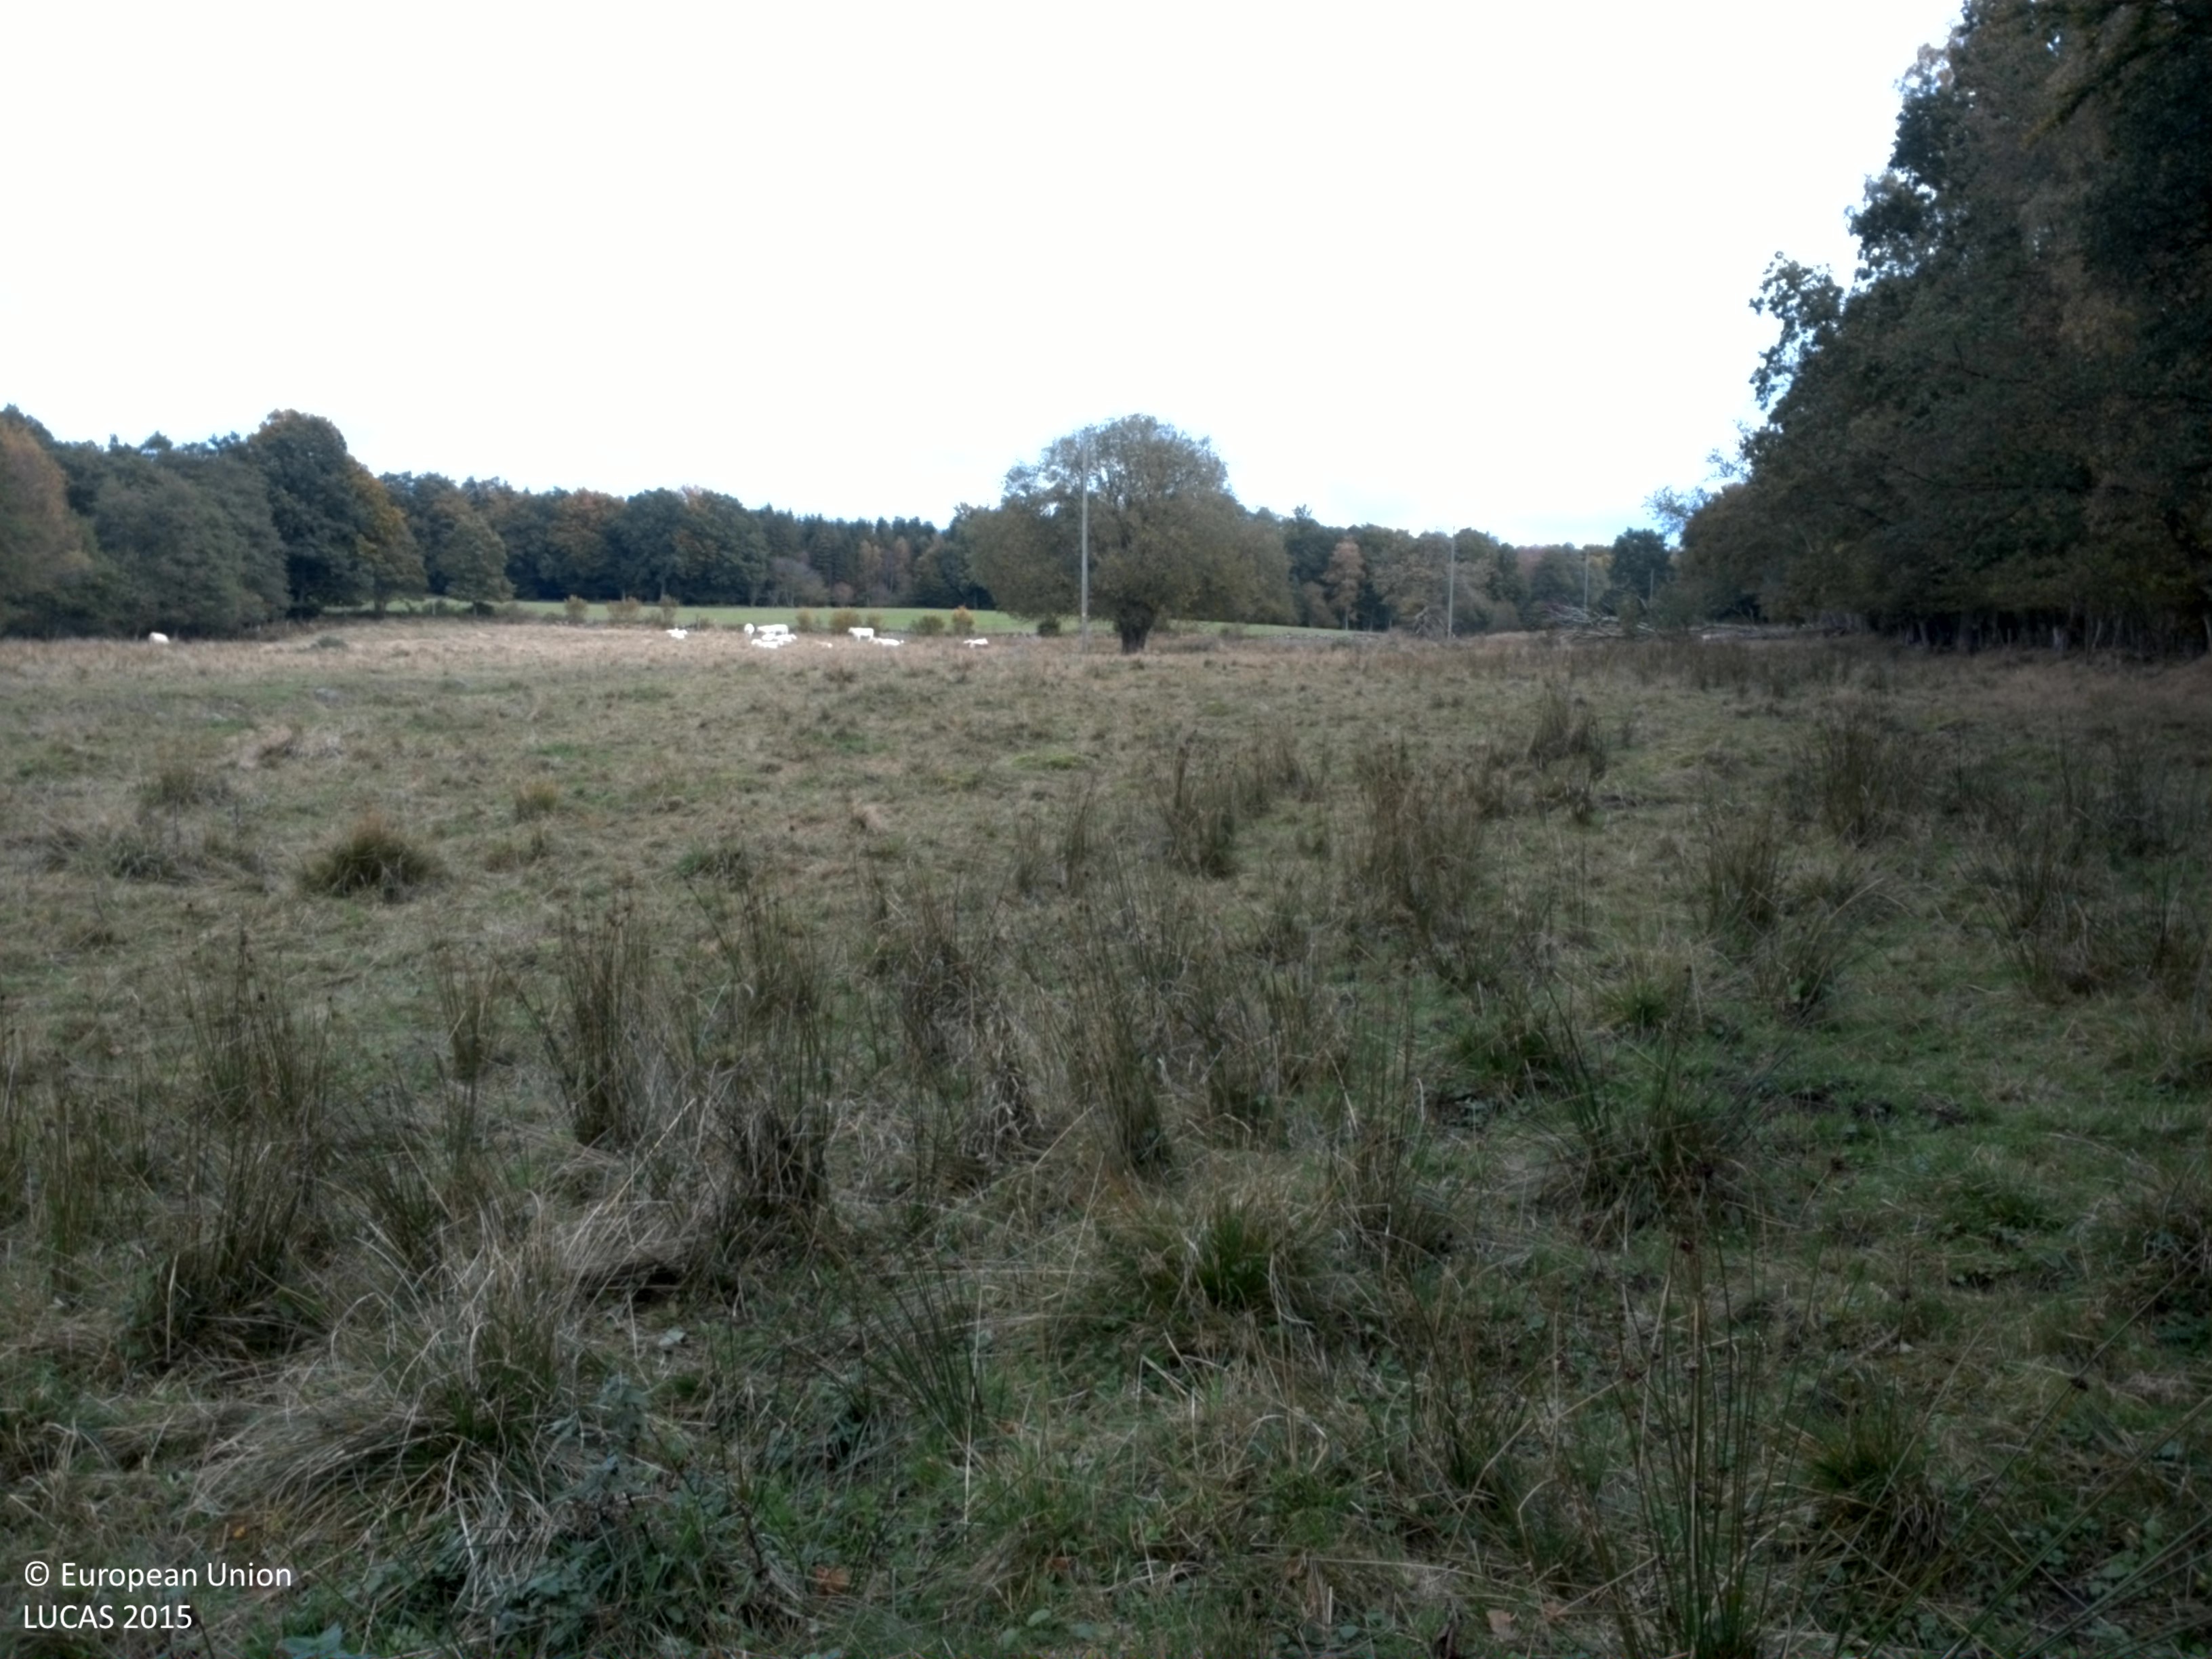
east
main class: Grassland
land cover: Grassland without tree/shrub cover
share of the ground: > 75 %
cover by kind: herbaceous plants 100 %
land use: Agriculture (excluding fallow land and kitchen gardens)
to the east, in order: Grassland without tree/shrub cover; Electric lines; Ditches and canals; Grassland without tree/shrub cover; Fences; Dry stone walls; Abandoned hedges; Fences; Grassland without tree/shrub cover
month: October
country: SE
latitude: 55.6918
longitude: 14.0549
